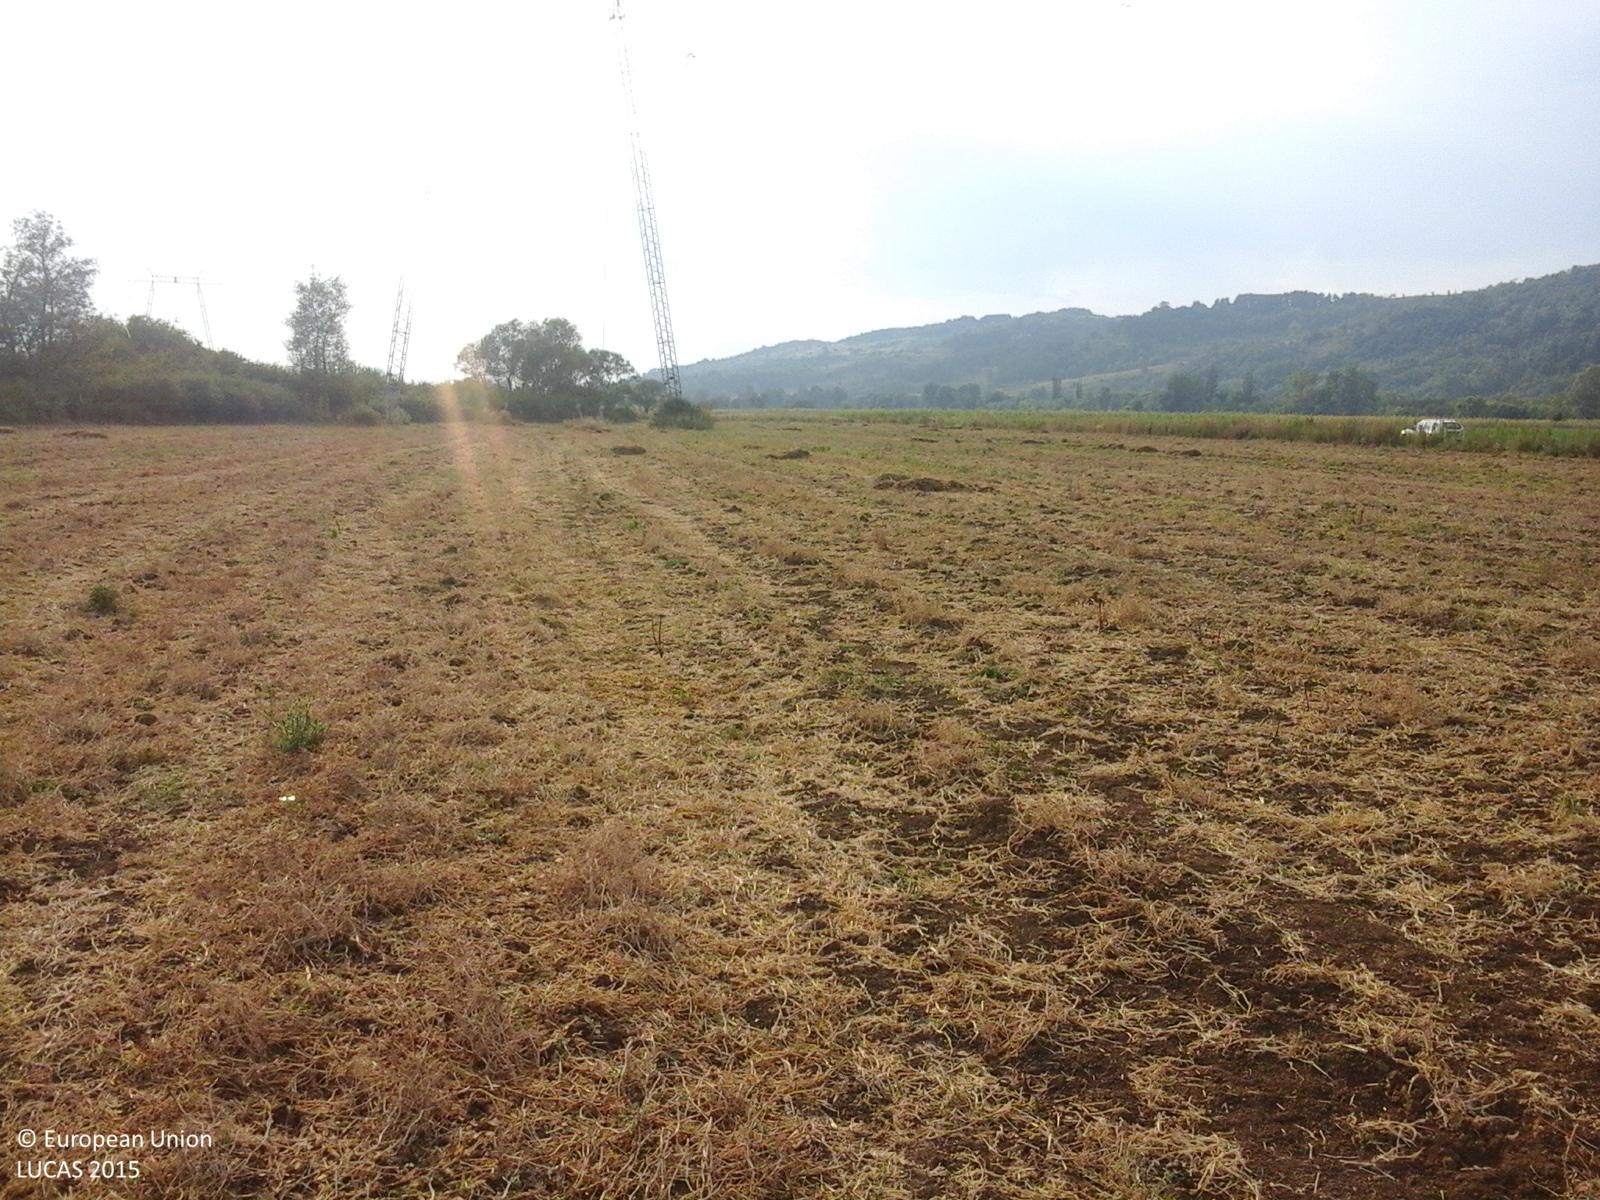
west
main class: Grassland
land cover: Spontaneously vegetated surfaces
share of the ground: > 75 %
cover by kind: herbaceous plants 100 %
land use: Fallow land
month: August
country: RO
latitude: 44.5863
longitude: 23.0071
